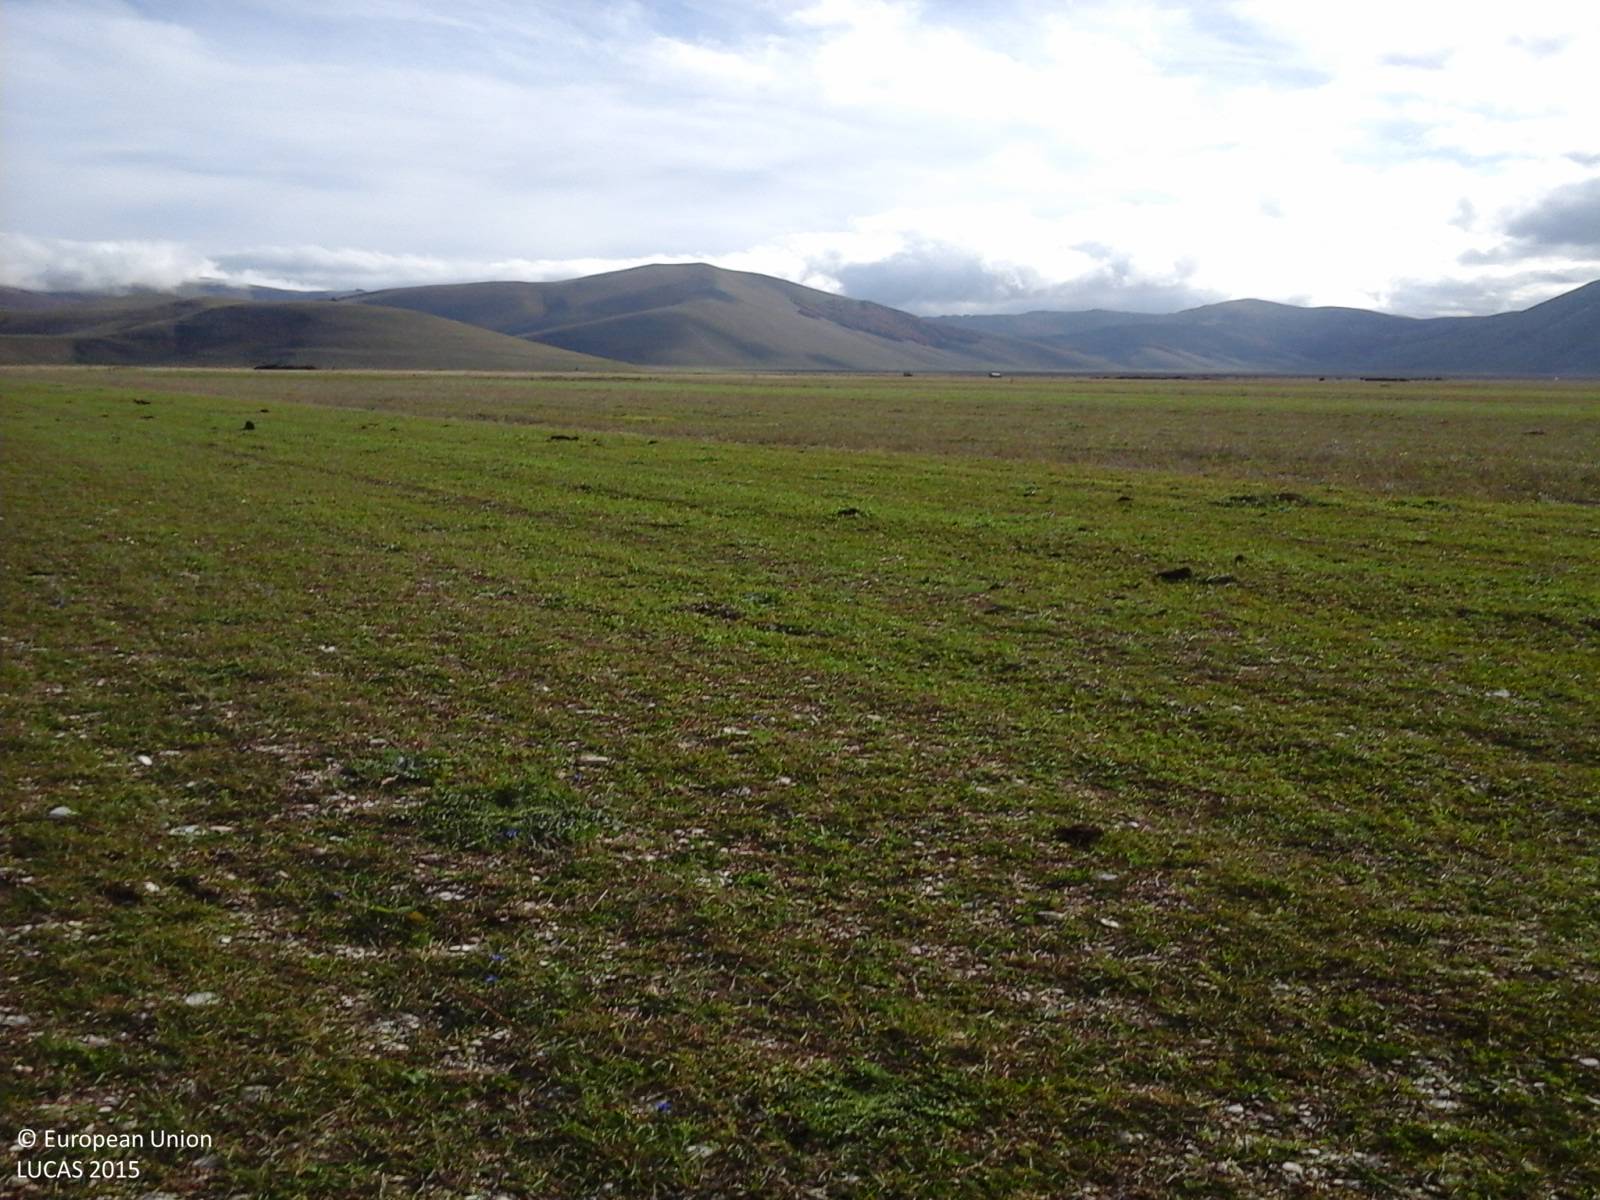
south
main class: Grassland
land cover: Grassland without tree/shrub cover
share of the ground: > 75 %
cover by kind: herbaceous plants 100 %
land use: Agriculture (excluding fallow land and kitchen gardens)
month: October
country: IT
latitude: 42.8201
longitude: 13.2074
